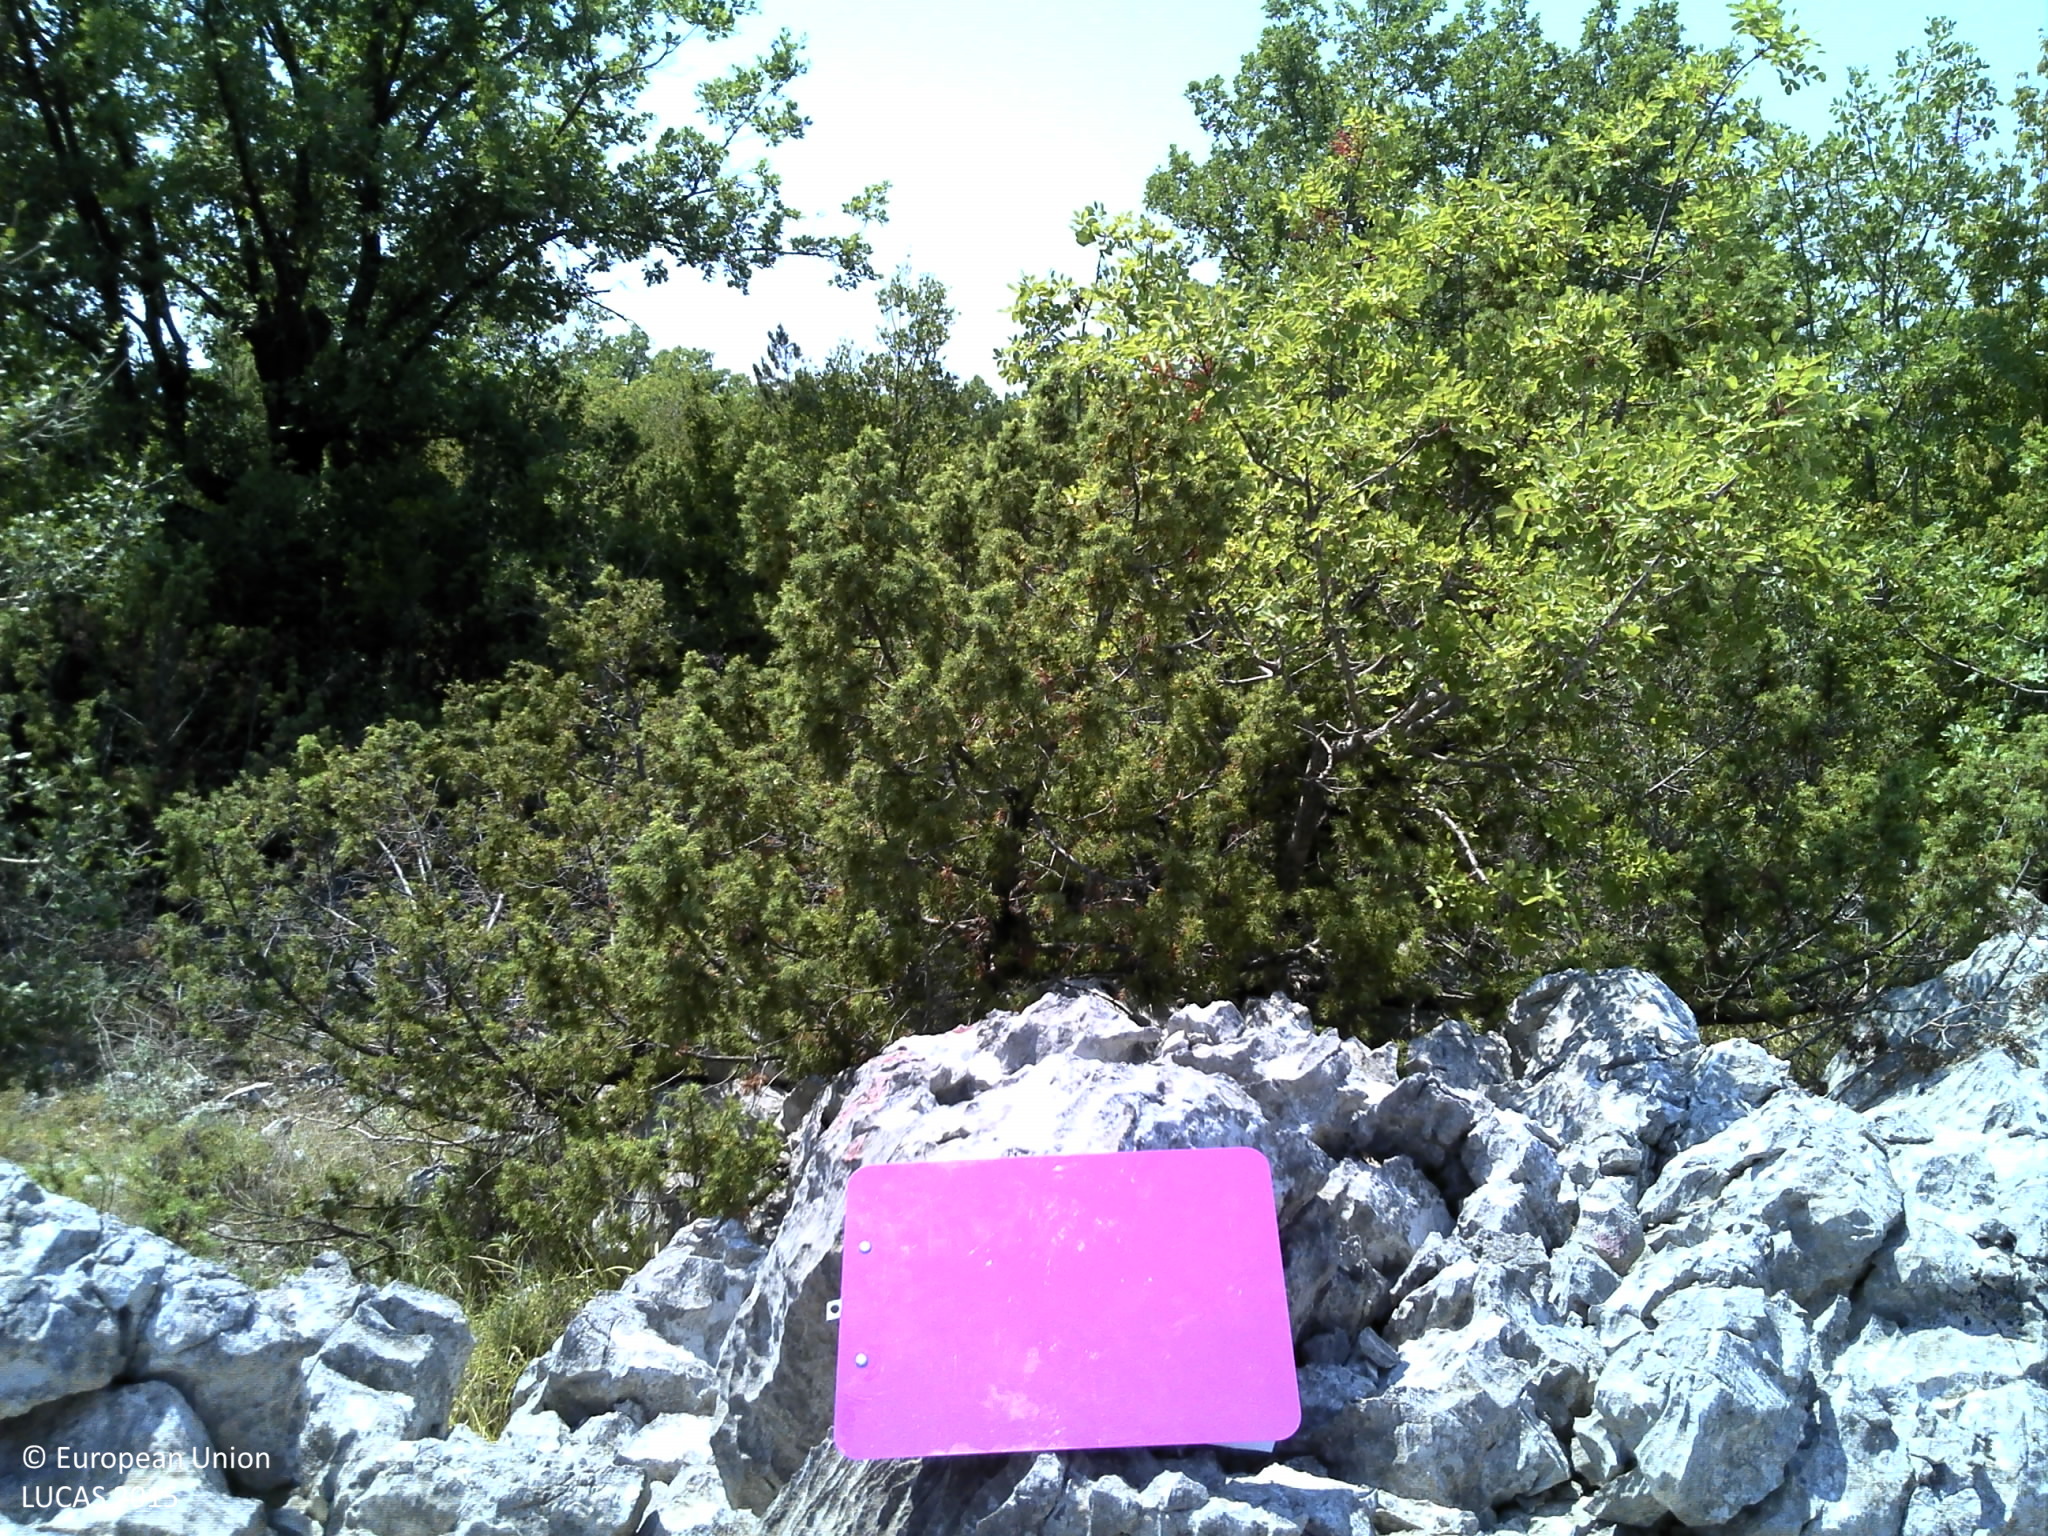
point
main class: Woodland
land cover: Broadleaved woodland
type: thermophilous deciduous forest
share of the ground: 25 - 50 %
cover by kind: broadleaved forest trees 35 %, shrubs 30 %, unconsolidated bare surface 20 %, consolidated bare surface 10 %, coniferous forest trees 5 %
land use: Semi-natural and natural areas not in use
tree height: > 5 m
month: July
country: HR
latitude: 42.9068
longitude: 17.6700
